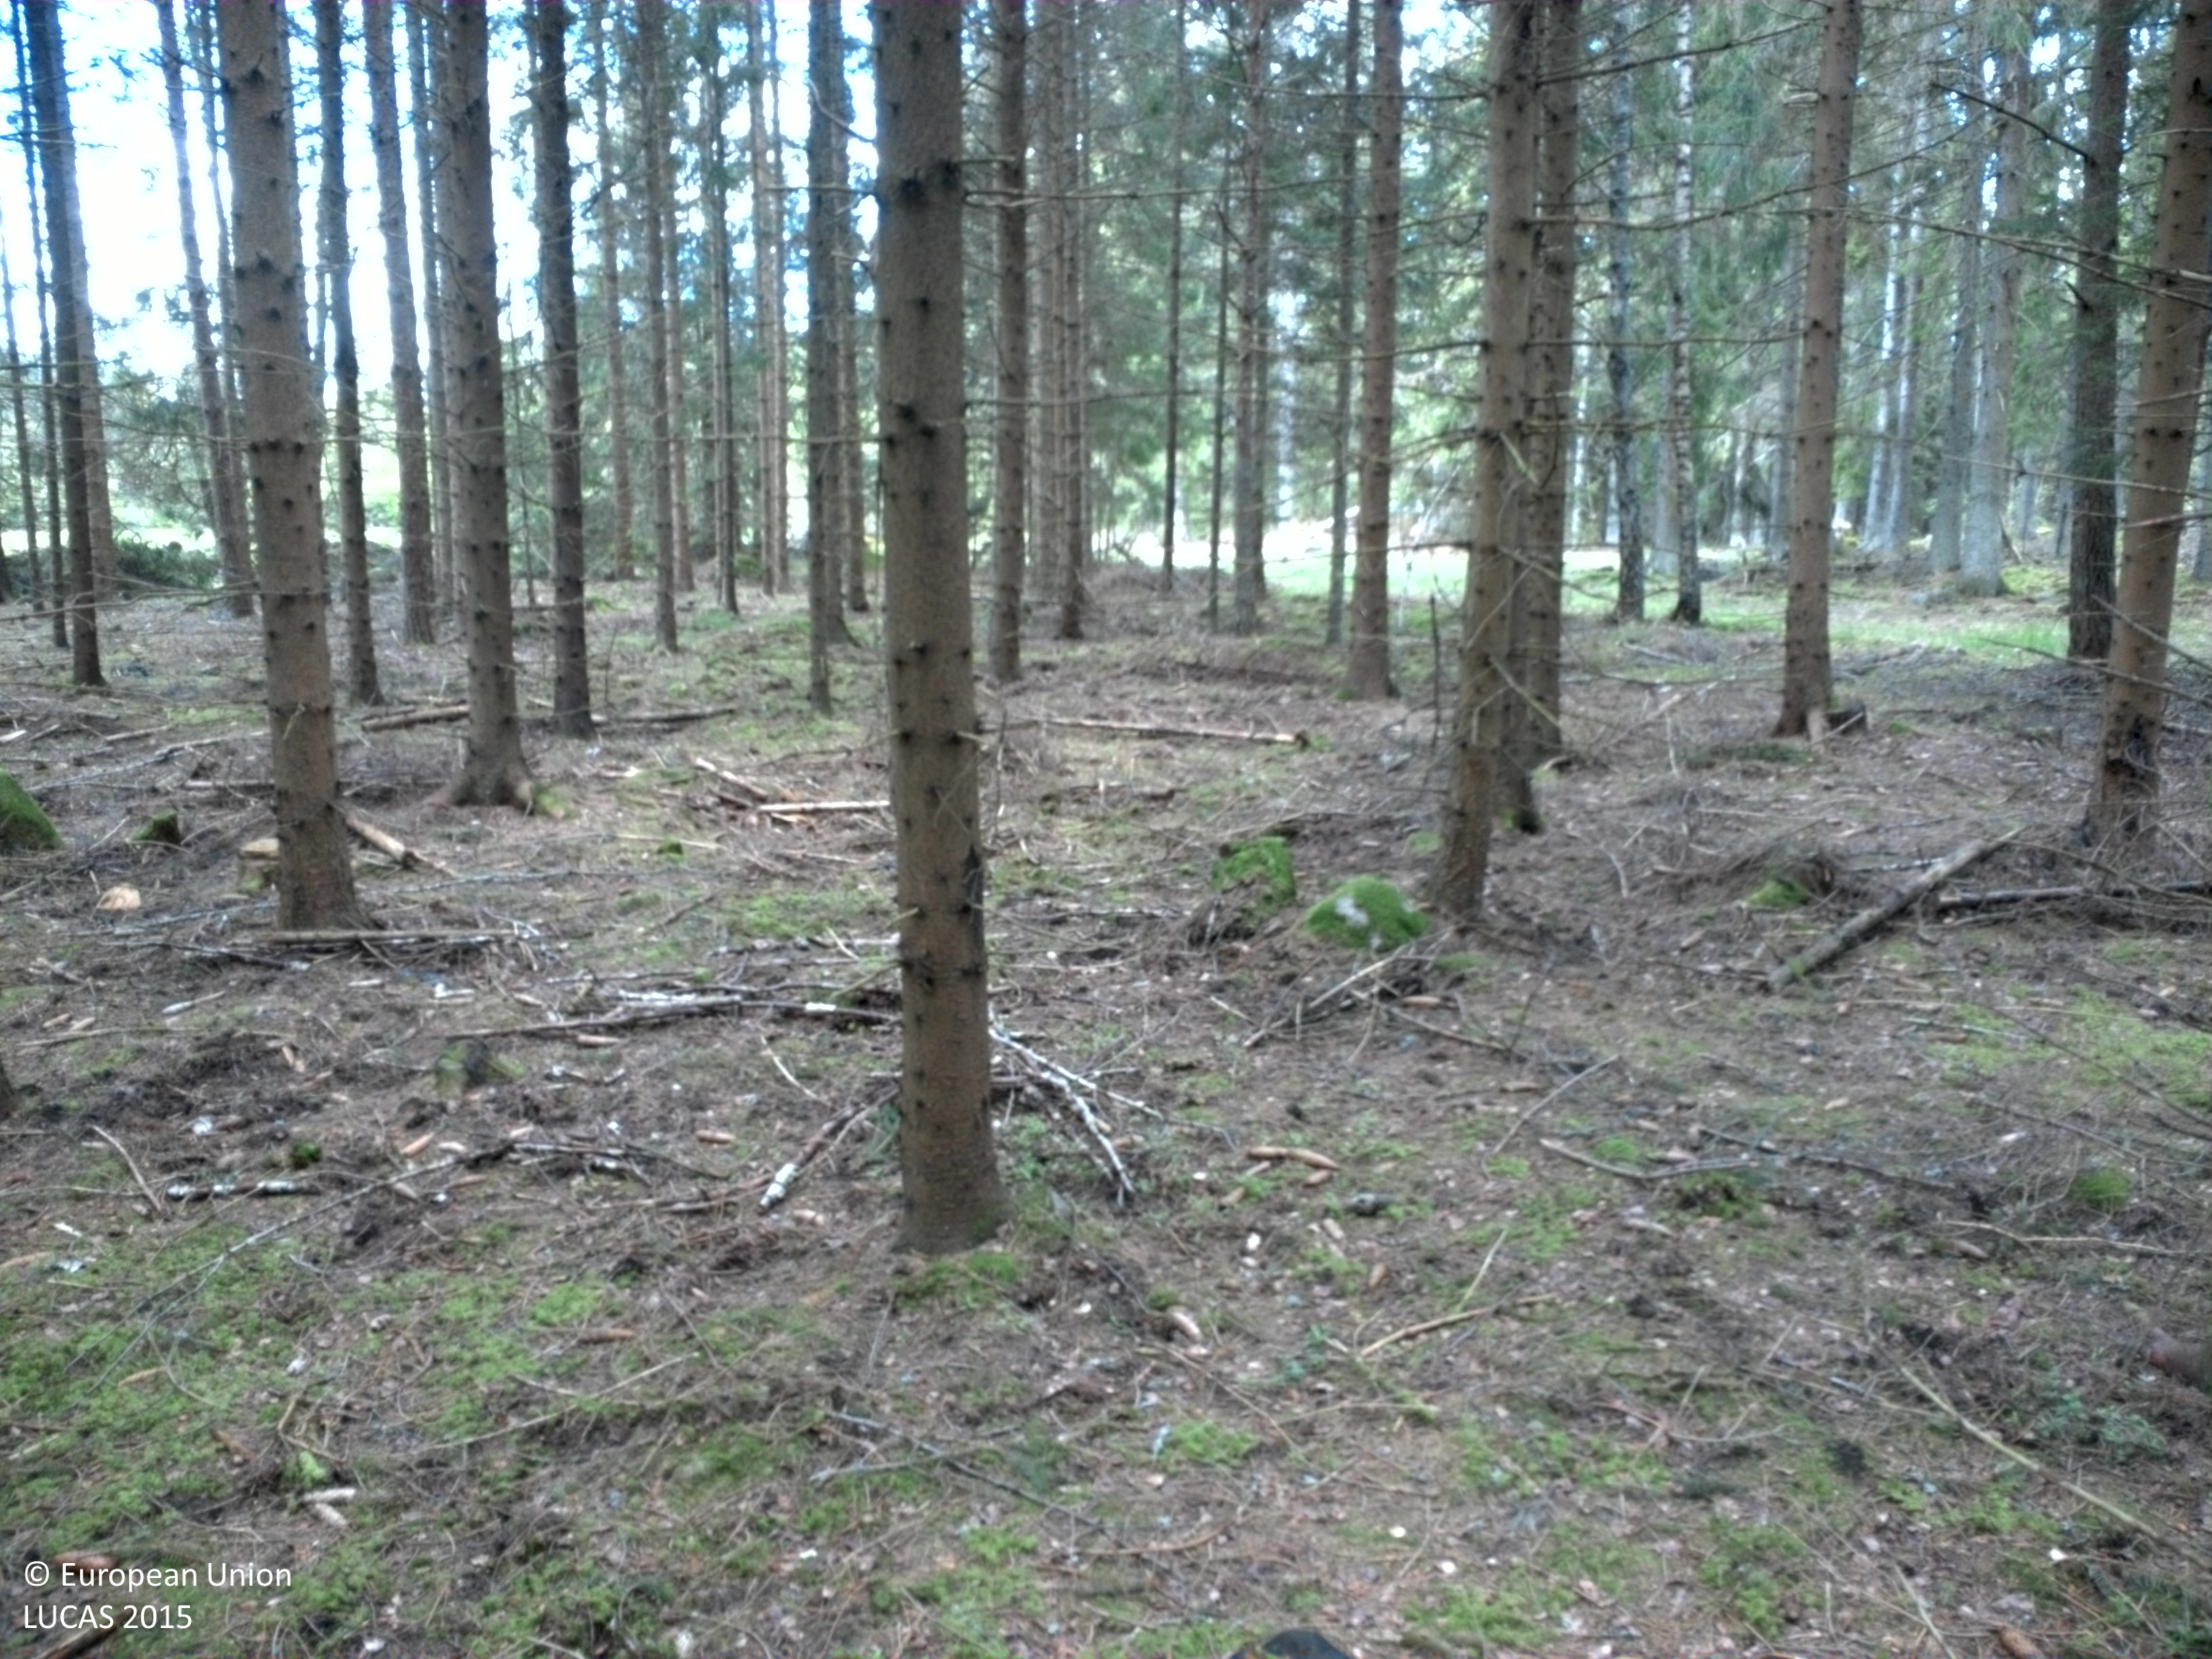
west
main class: Woodland
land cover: Spruce dominated coniferous woodland
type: boreal forest
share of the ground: > 75 %
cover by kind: coniferous forest trees 95 %, broadleaved forest trees 5 %
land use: Forestry
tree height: > 5 m
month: May
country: SE
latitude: 56.4884
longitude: 15.4069
